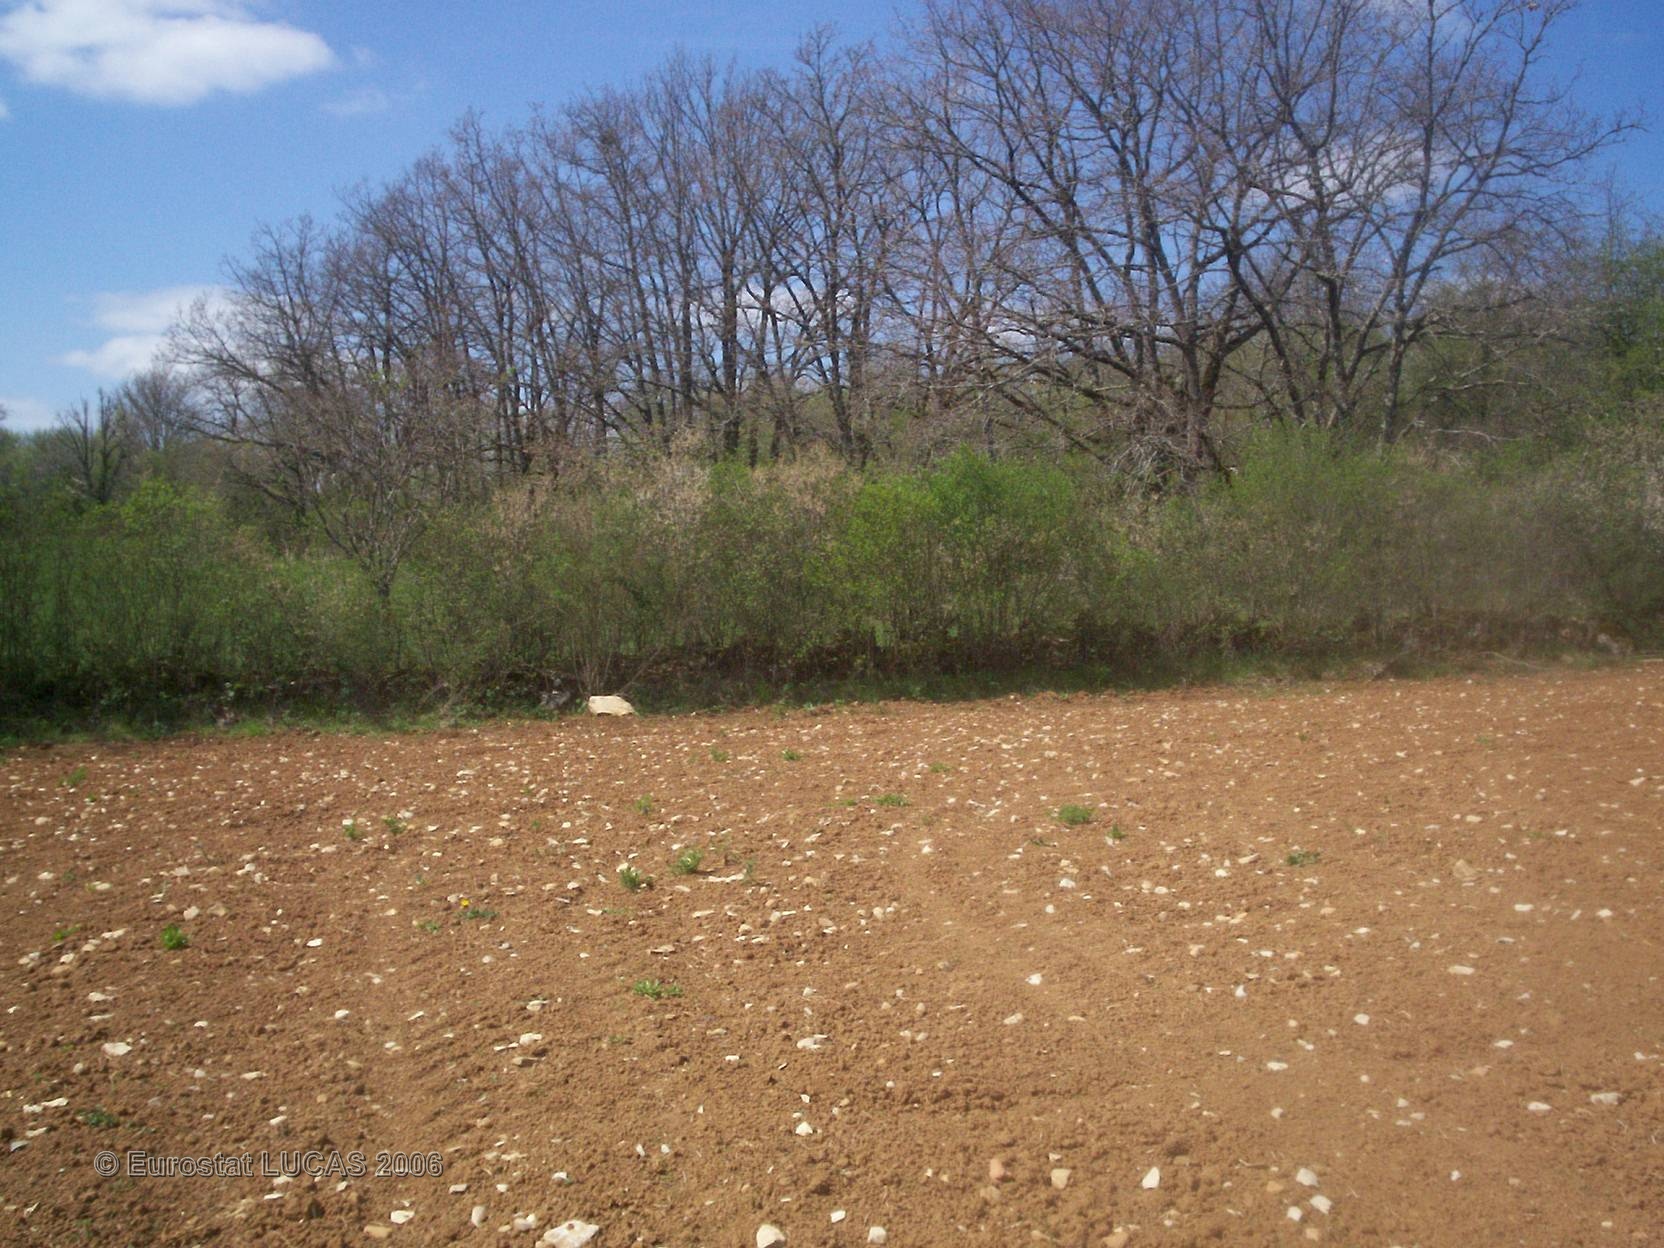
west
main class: Cropland
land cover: Clovers
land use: Agriculture (excluding fallow land and kitchen gardens)
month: May
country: FR
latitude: 44.3264
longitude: 1.9380
